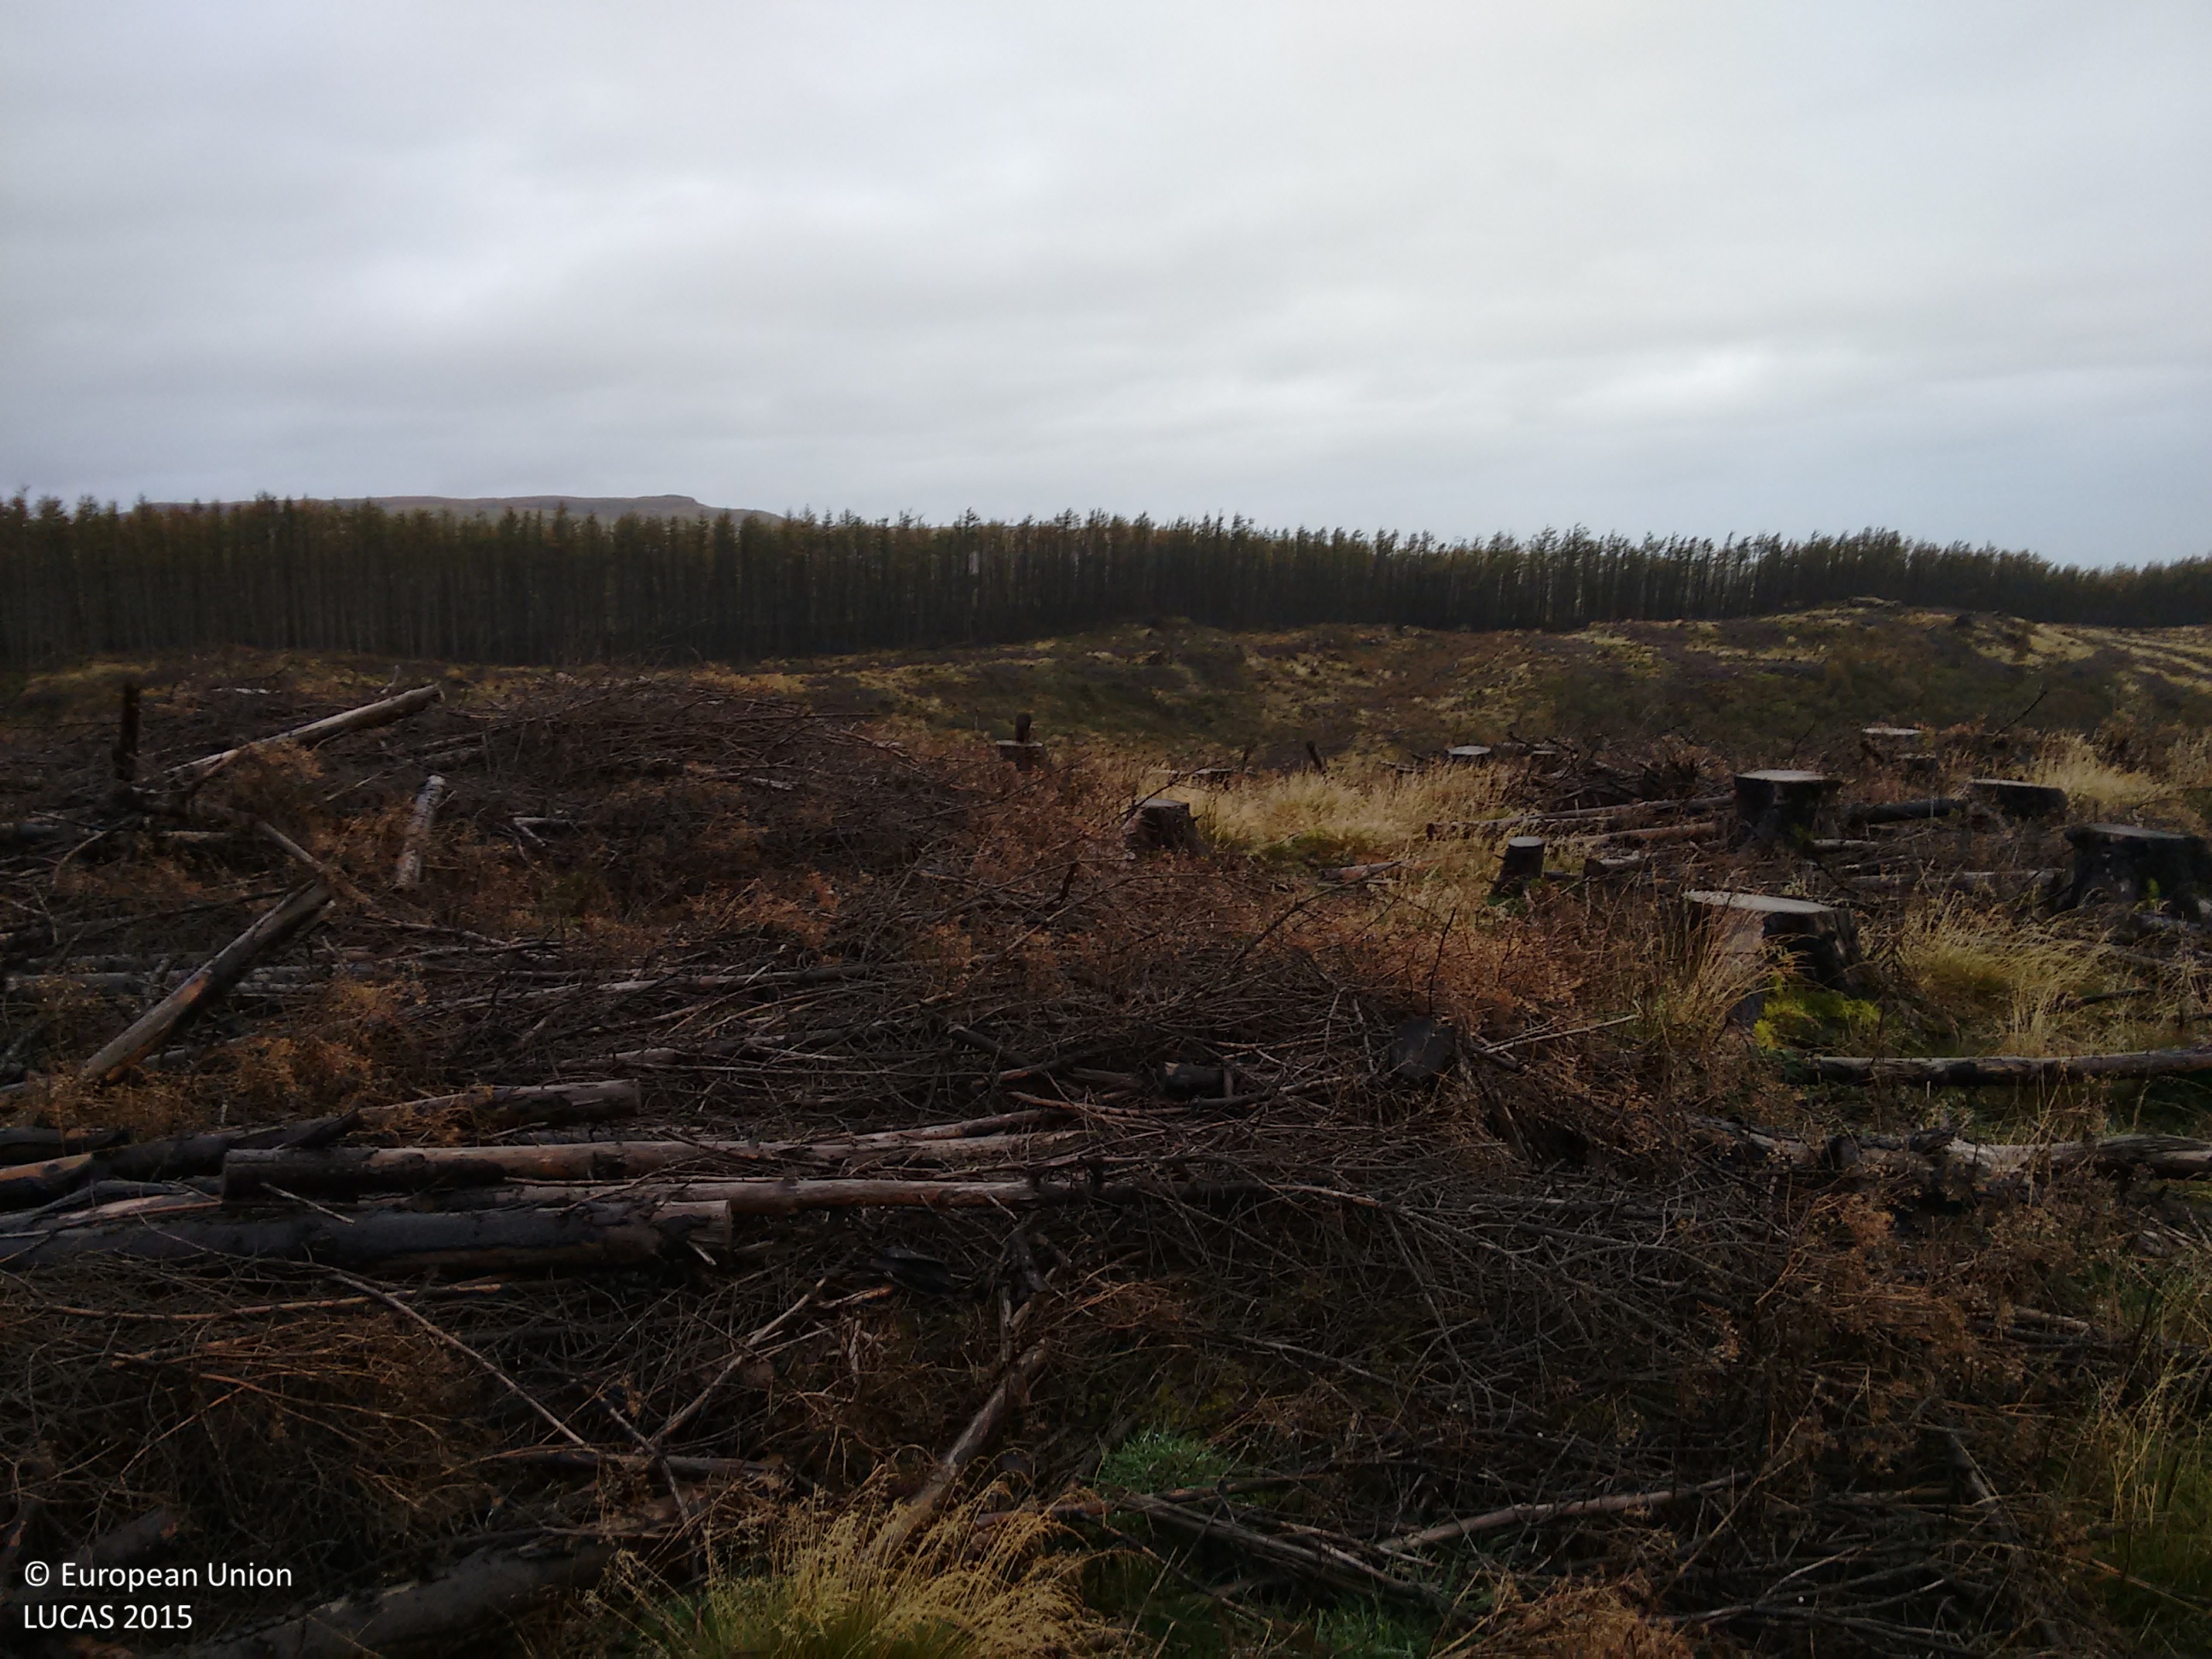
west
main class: Grassland
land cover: Grassland without tree/shrub cover
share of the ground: > 75 %
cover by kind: herbaceous plants 75 %, lichens and mosses 5 %
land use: Forestry
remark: Clear cut
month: October
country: GB
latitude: 56.5948
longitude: -6.2469
